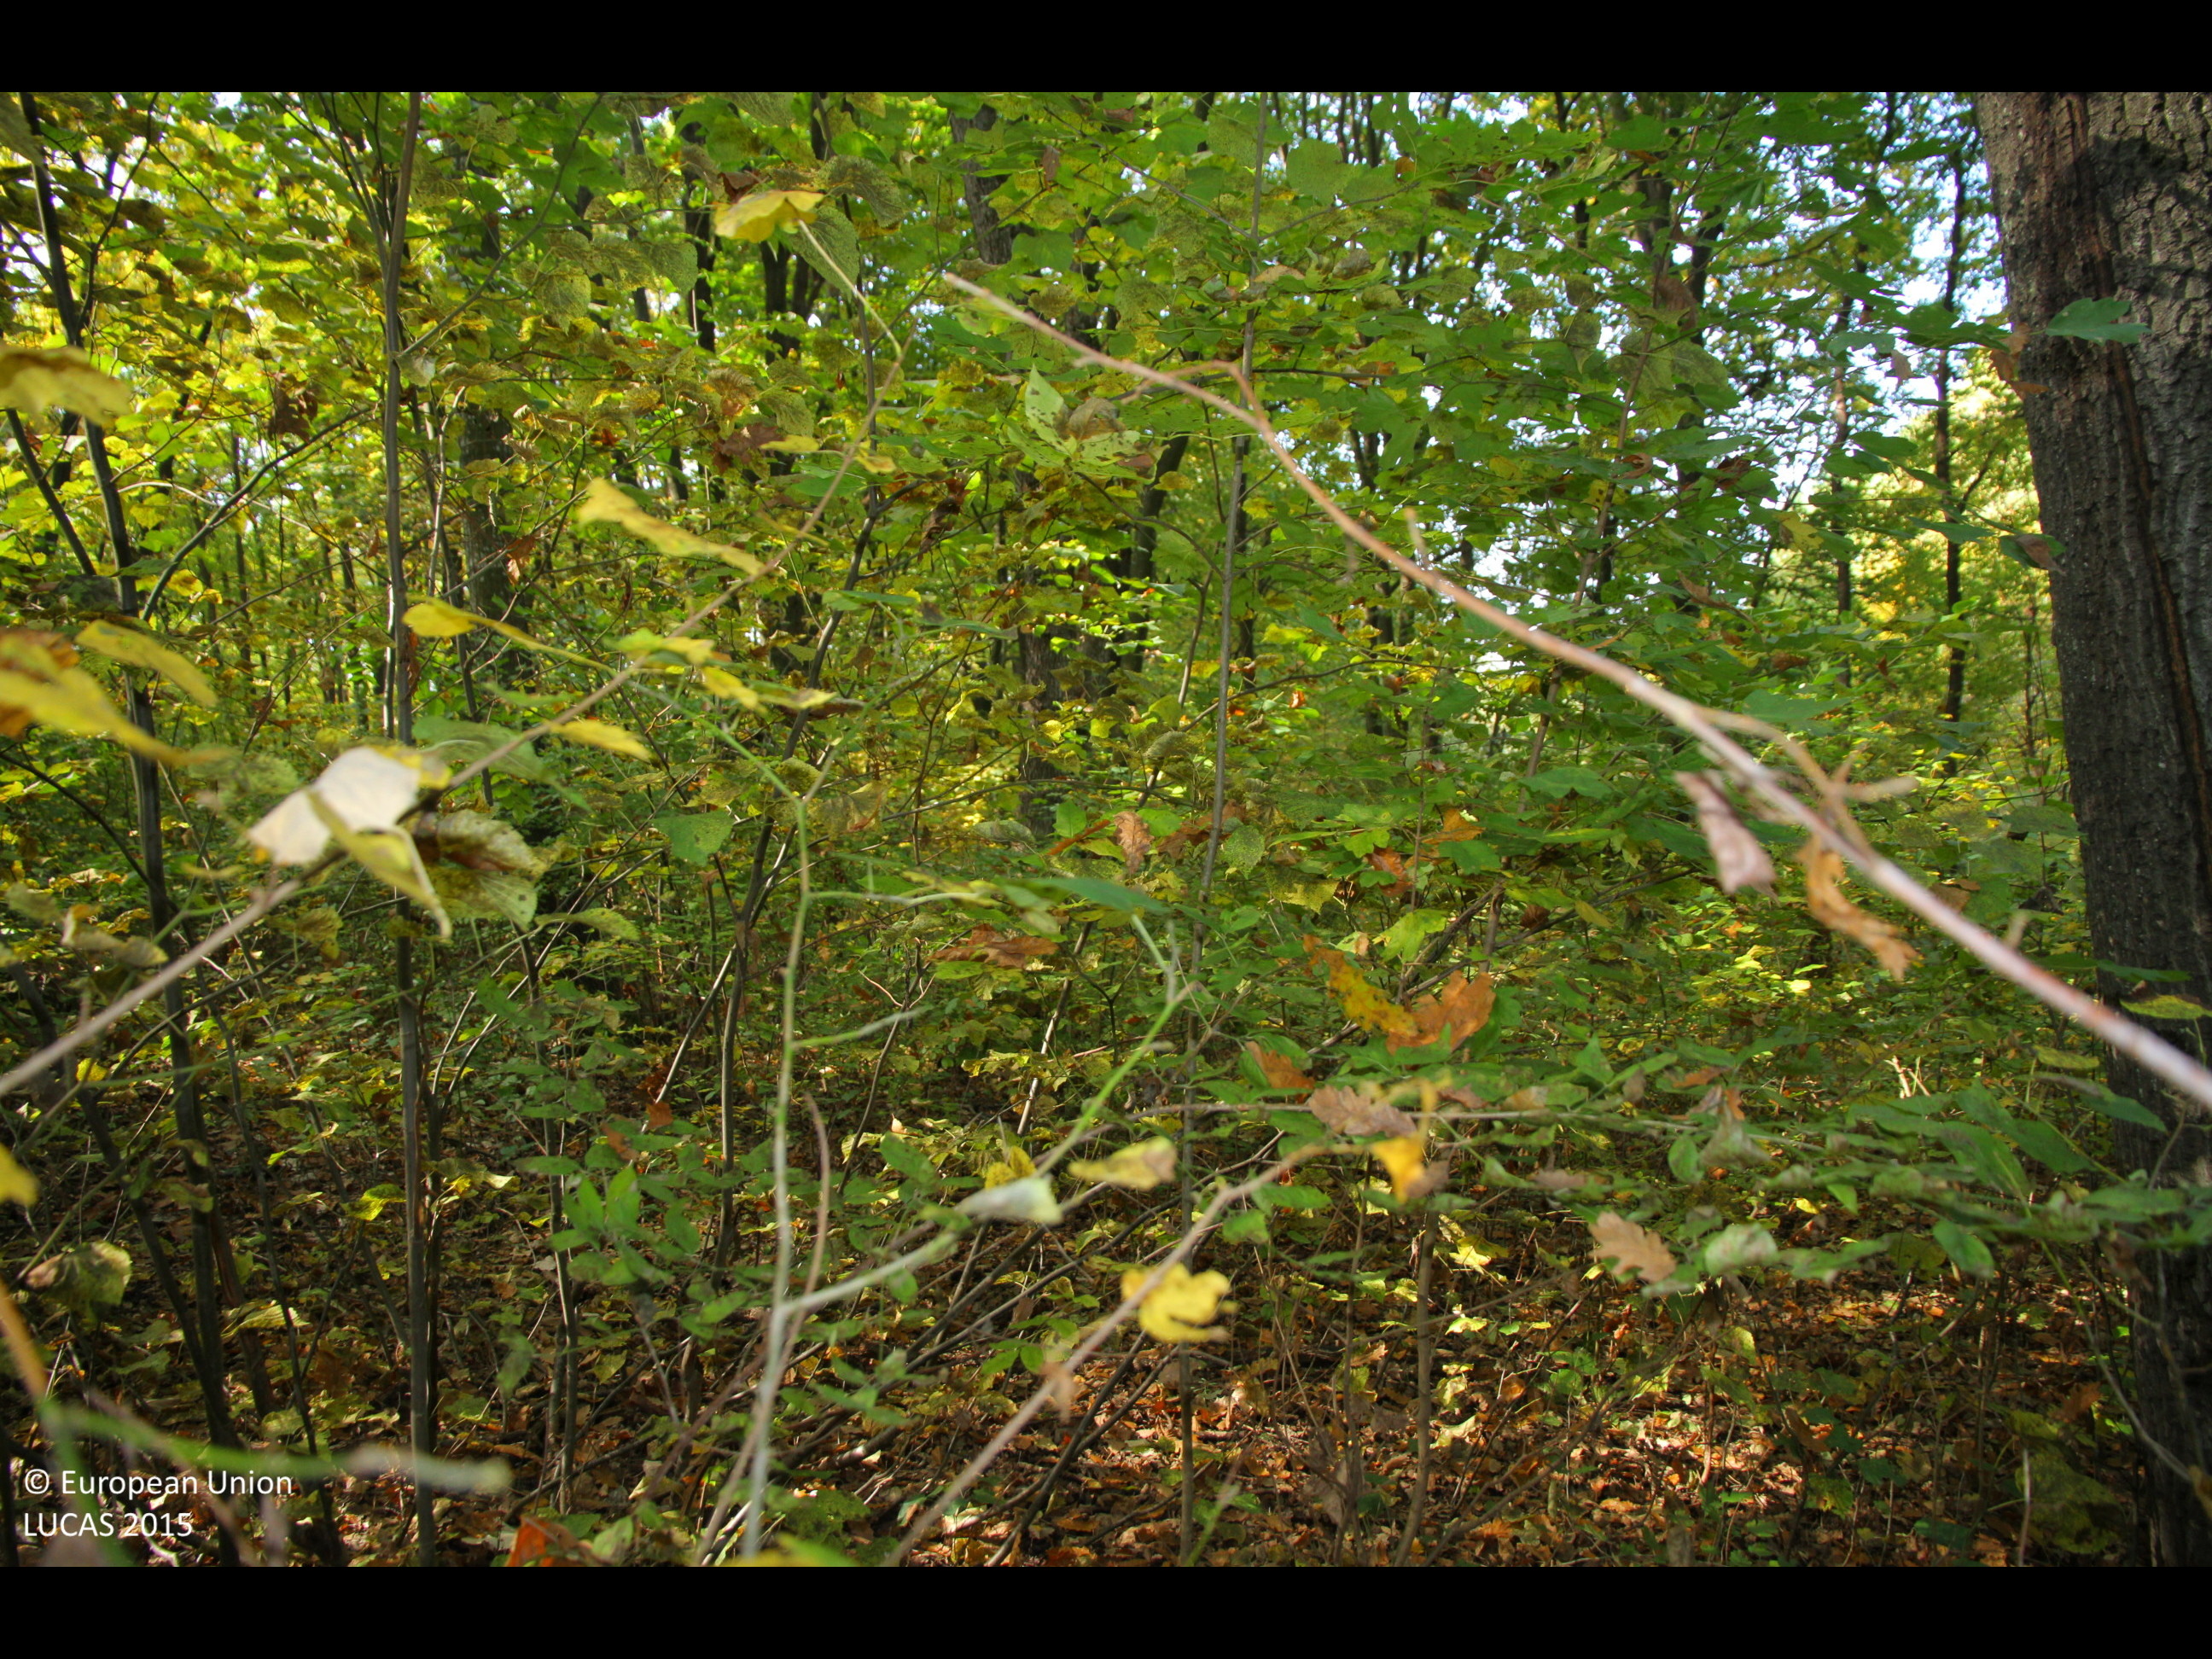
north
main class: Woodland
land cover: Broadleaved woodland
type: mesophytic deciduous forest
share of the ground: > 75 %
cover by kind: broadleaved forest trees 100 %
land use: Forestry
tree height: > 5 m
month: October
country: BG
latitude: 43.1726
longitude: 26.9020
